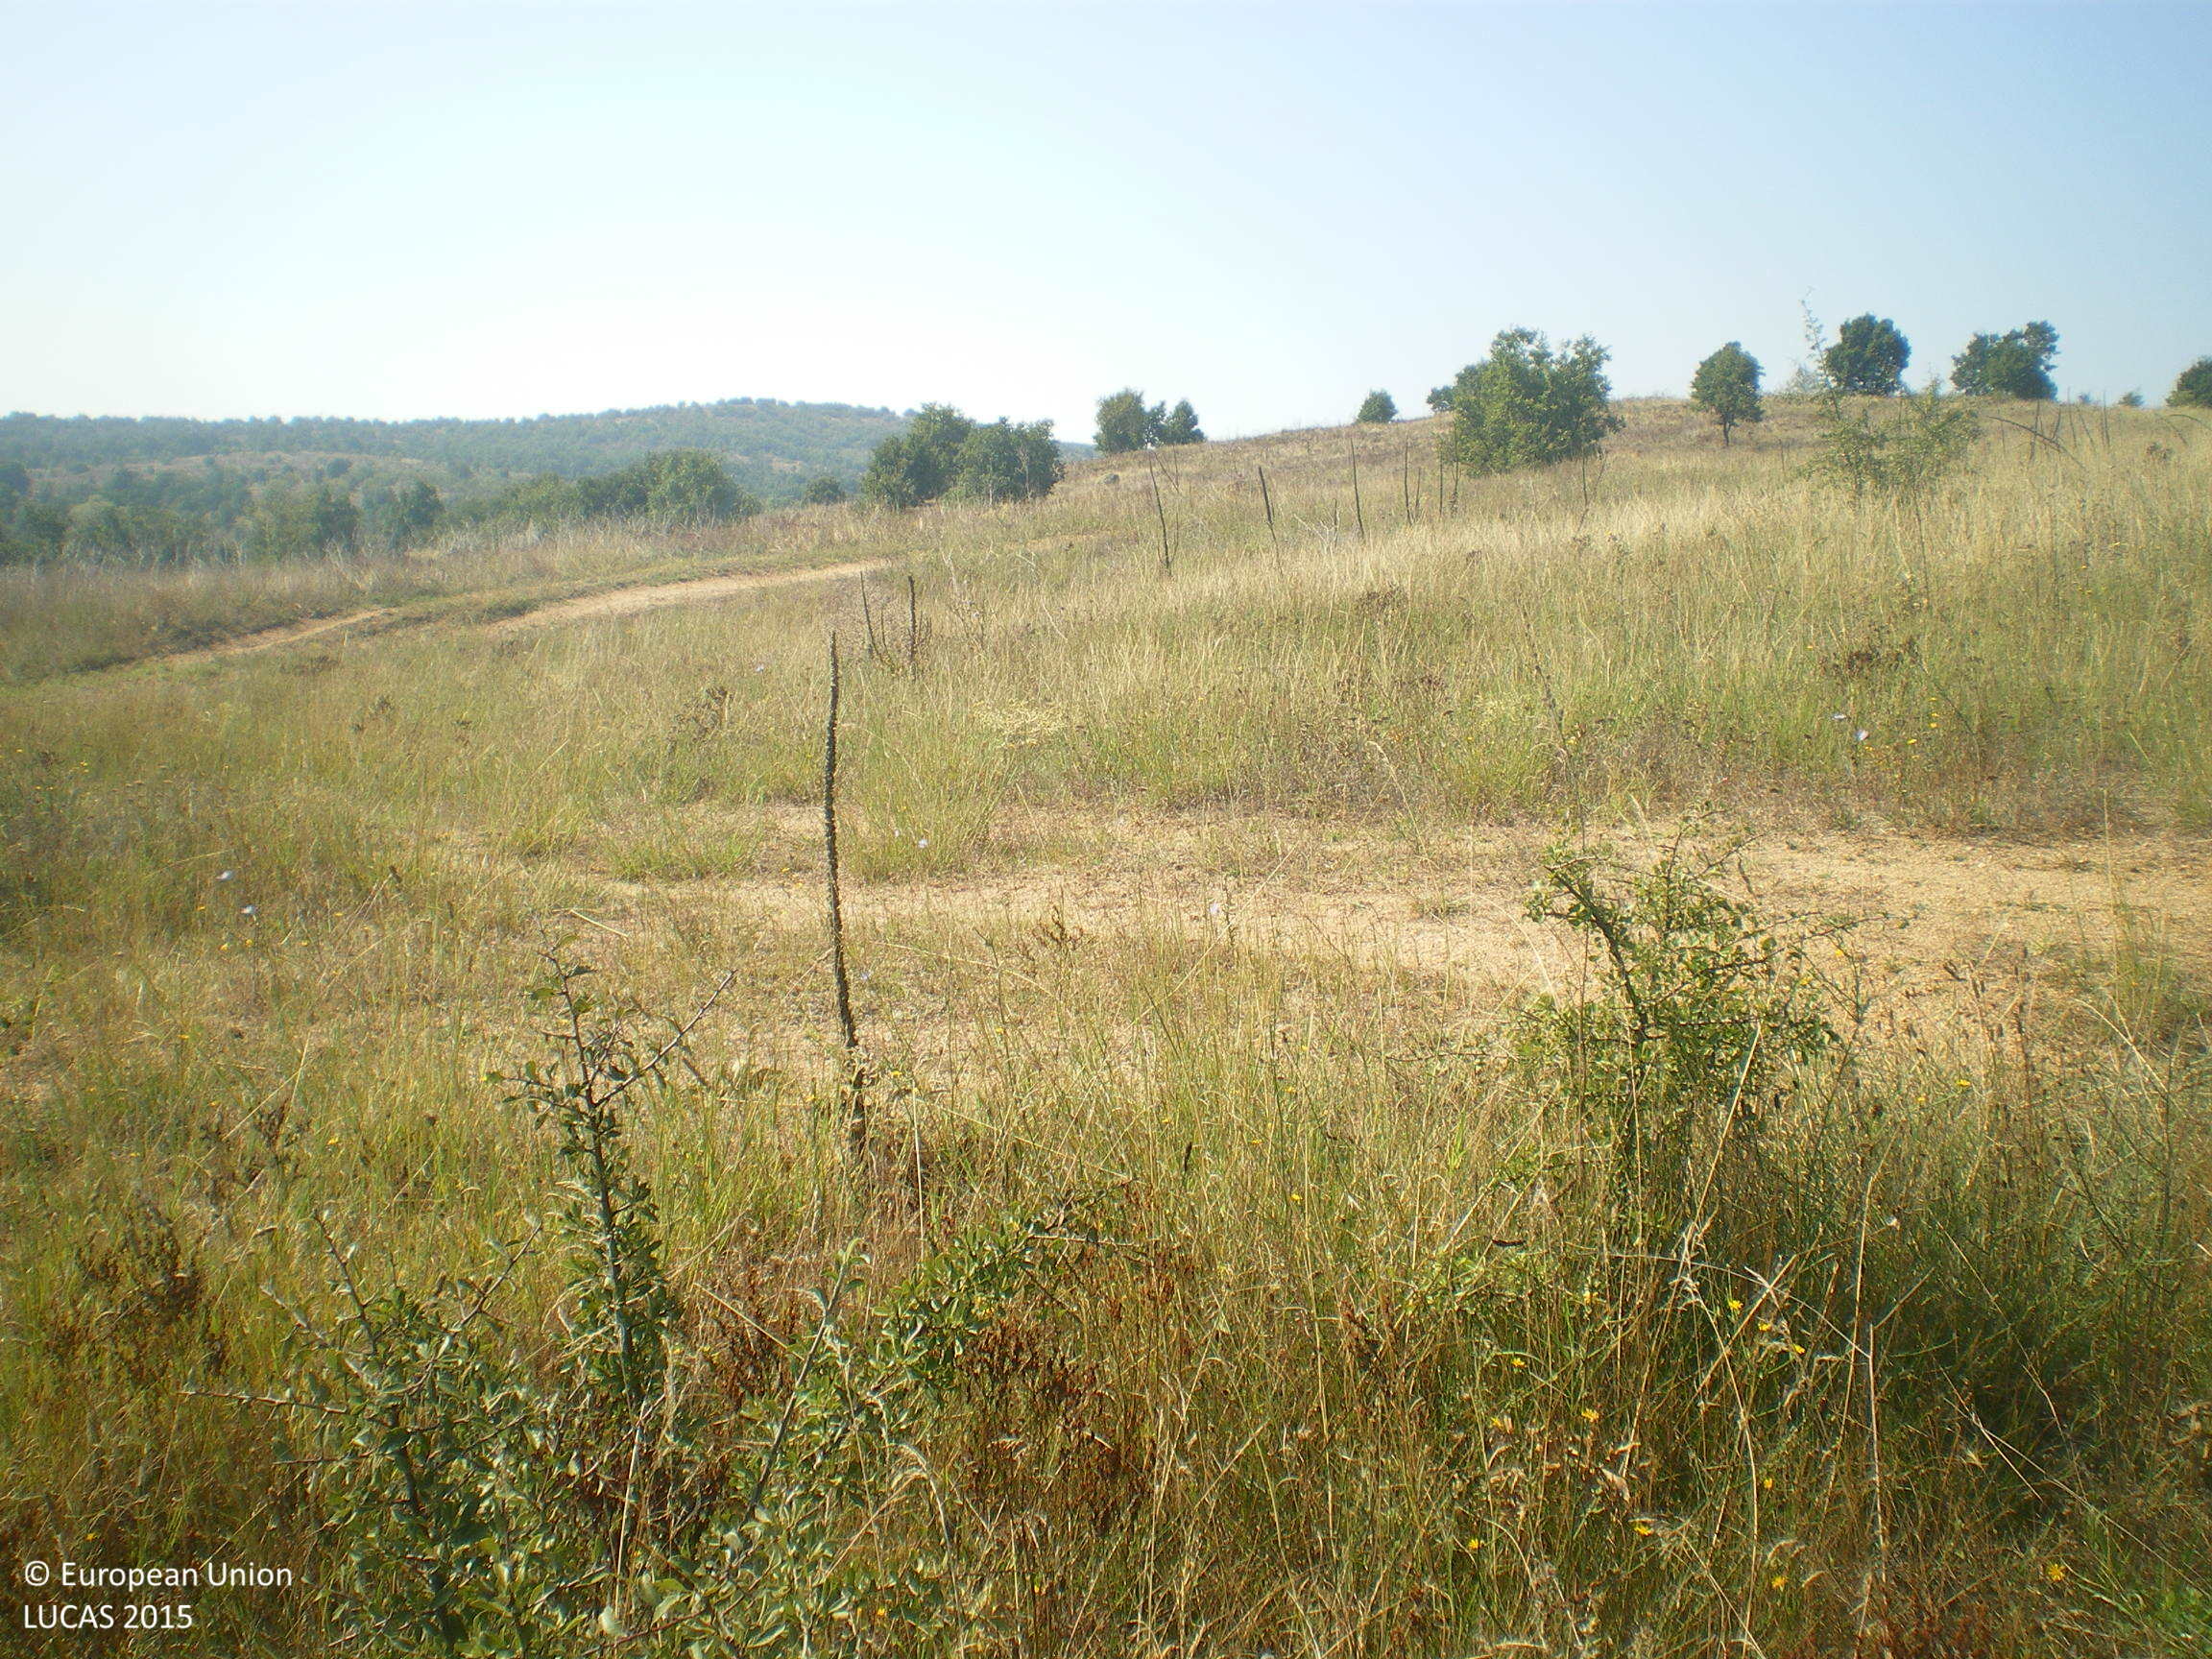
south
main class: Grassland
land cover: Grassland with sparse tree/shrub cover
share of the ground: > 75 %
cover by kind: herbaceous plants 90 %, broadleaved forest trees 5 %, shrubs 5 %
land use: Semi-natural and natural areas not in use
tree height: > 5 m
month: August
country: BG
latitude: 42.0114
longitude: 26.0262
